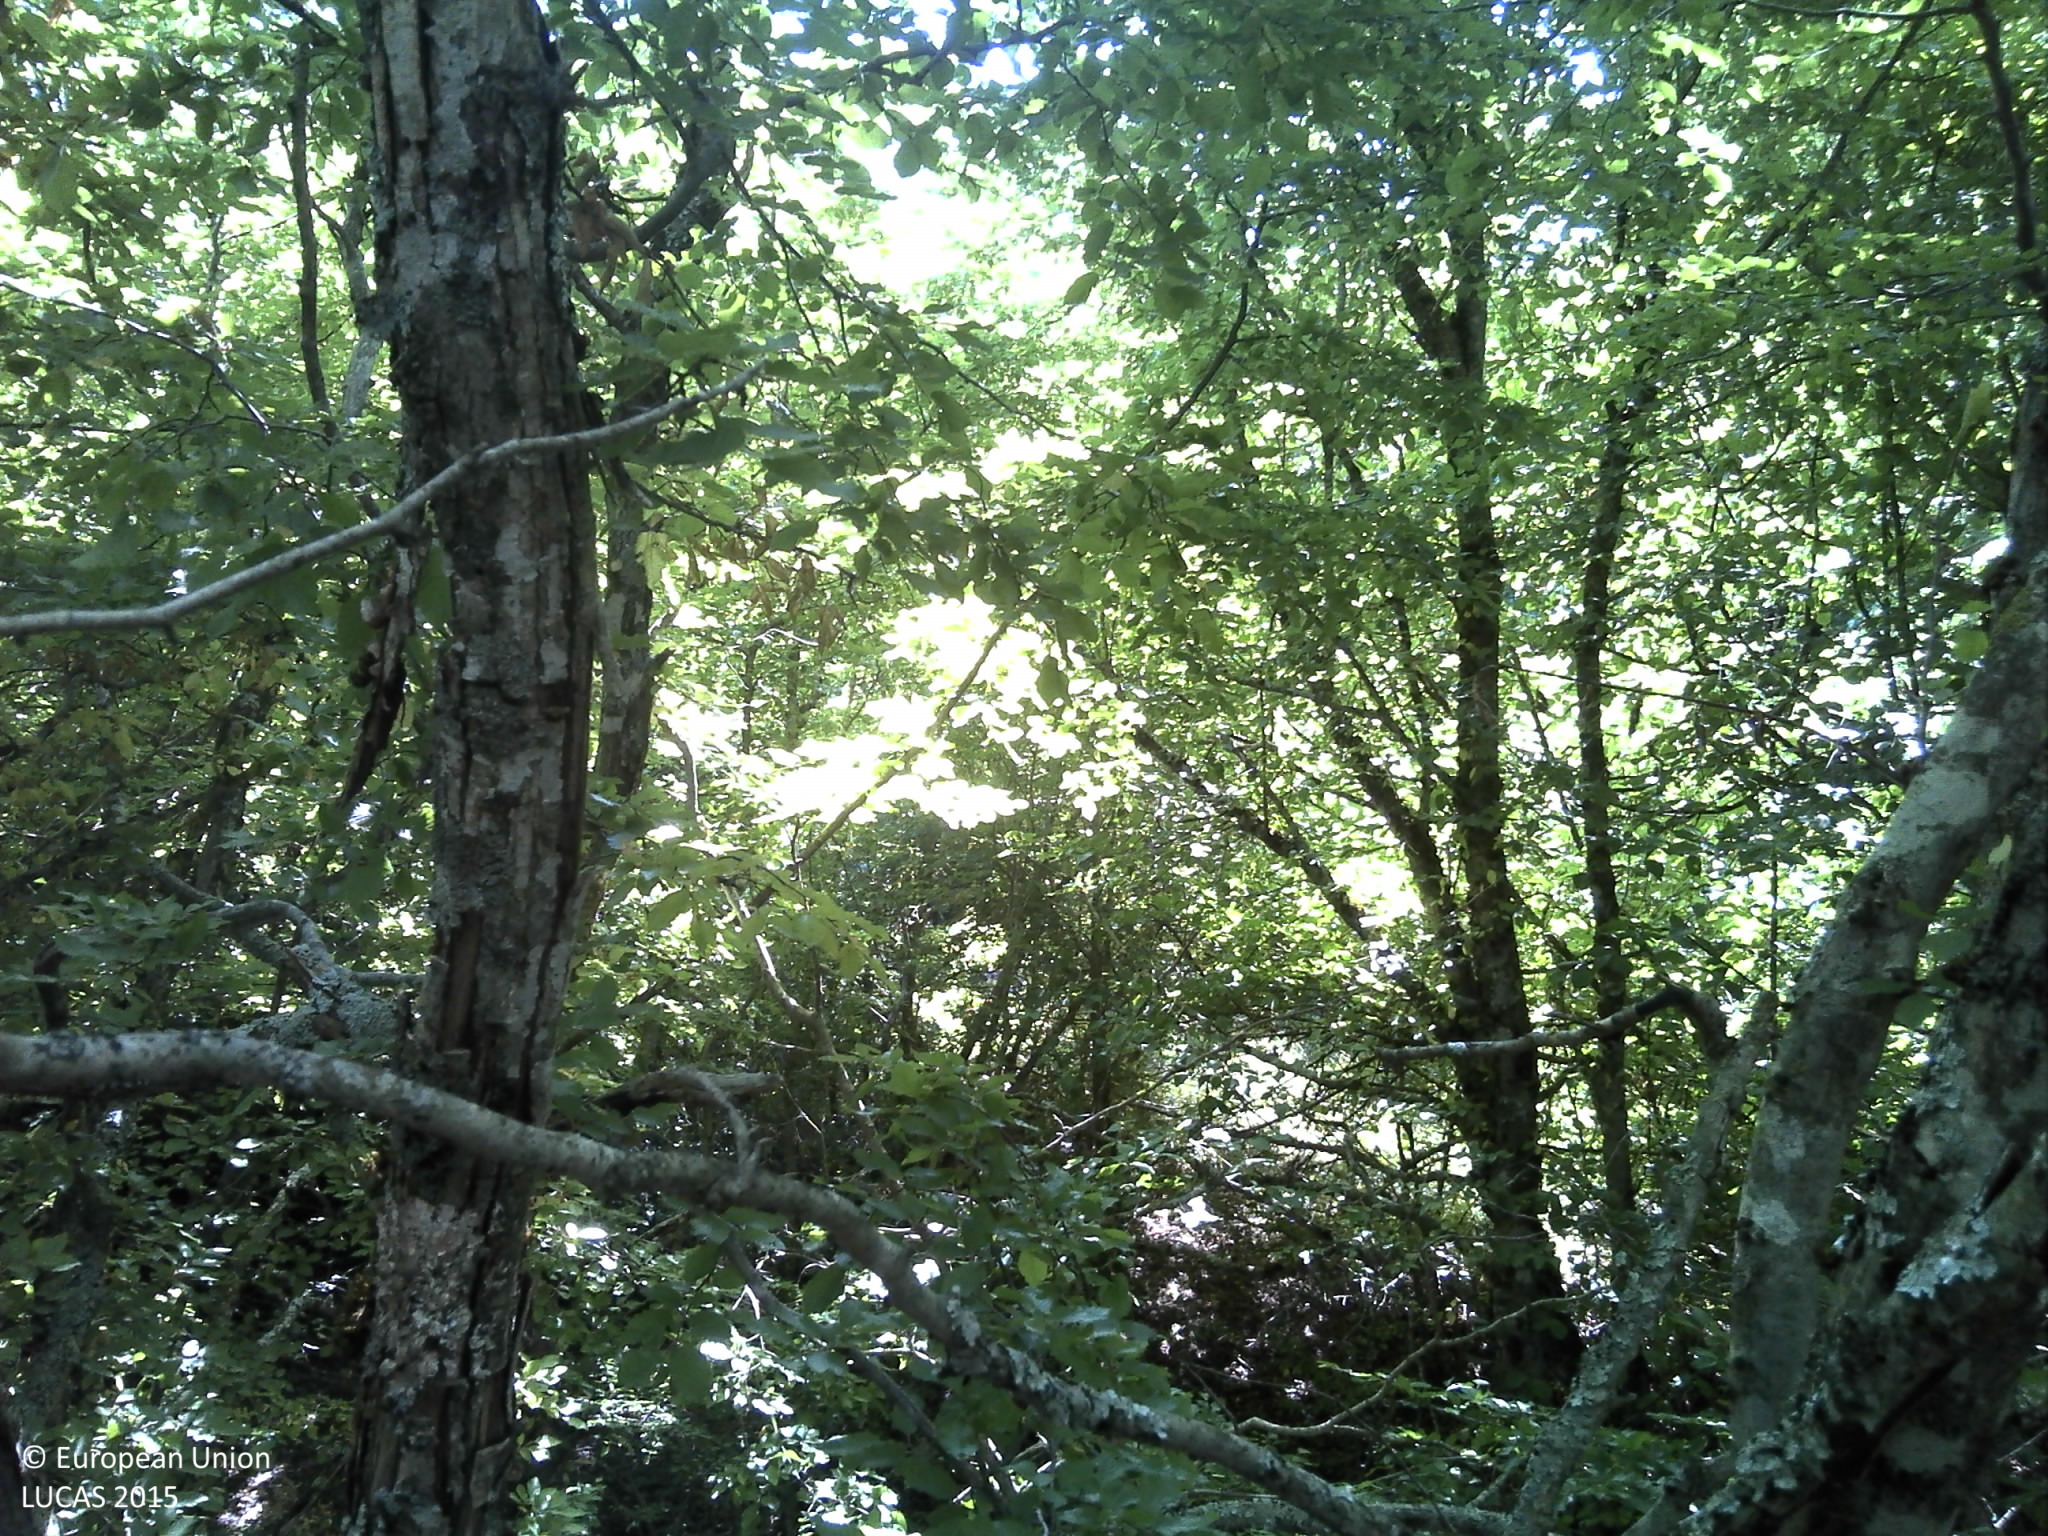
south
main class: Woodland
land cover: Broadleaved woodland
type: thermophilous deciduous forest
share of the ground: 50 - 75 %
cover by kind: broadleaved forest trees 70 %, shrubs 15 %, herbaceous plants 10 %, consolidated bare surface 5 %
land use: Semi-natural and natural areas not in use
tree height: > 5 m
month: July
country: HR
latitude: 43.5308
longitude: 17.0574
